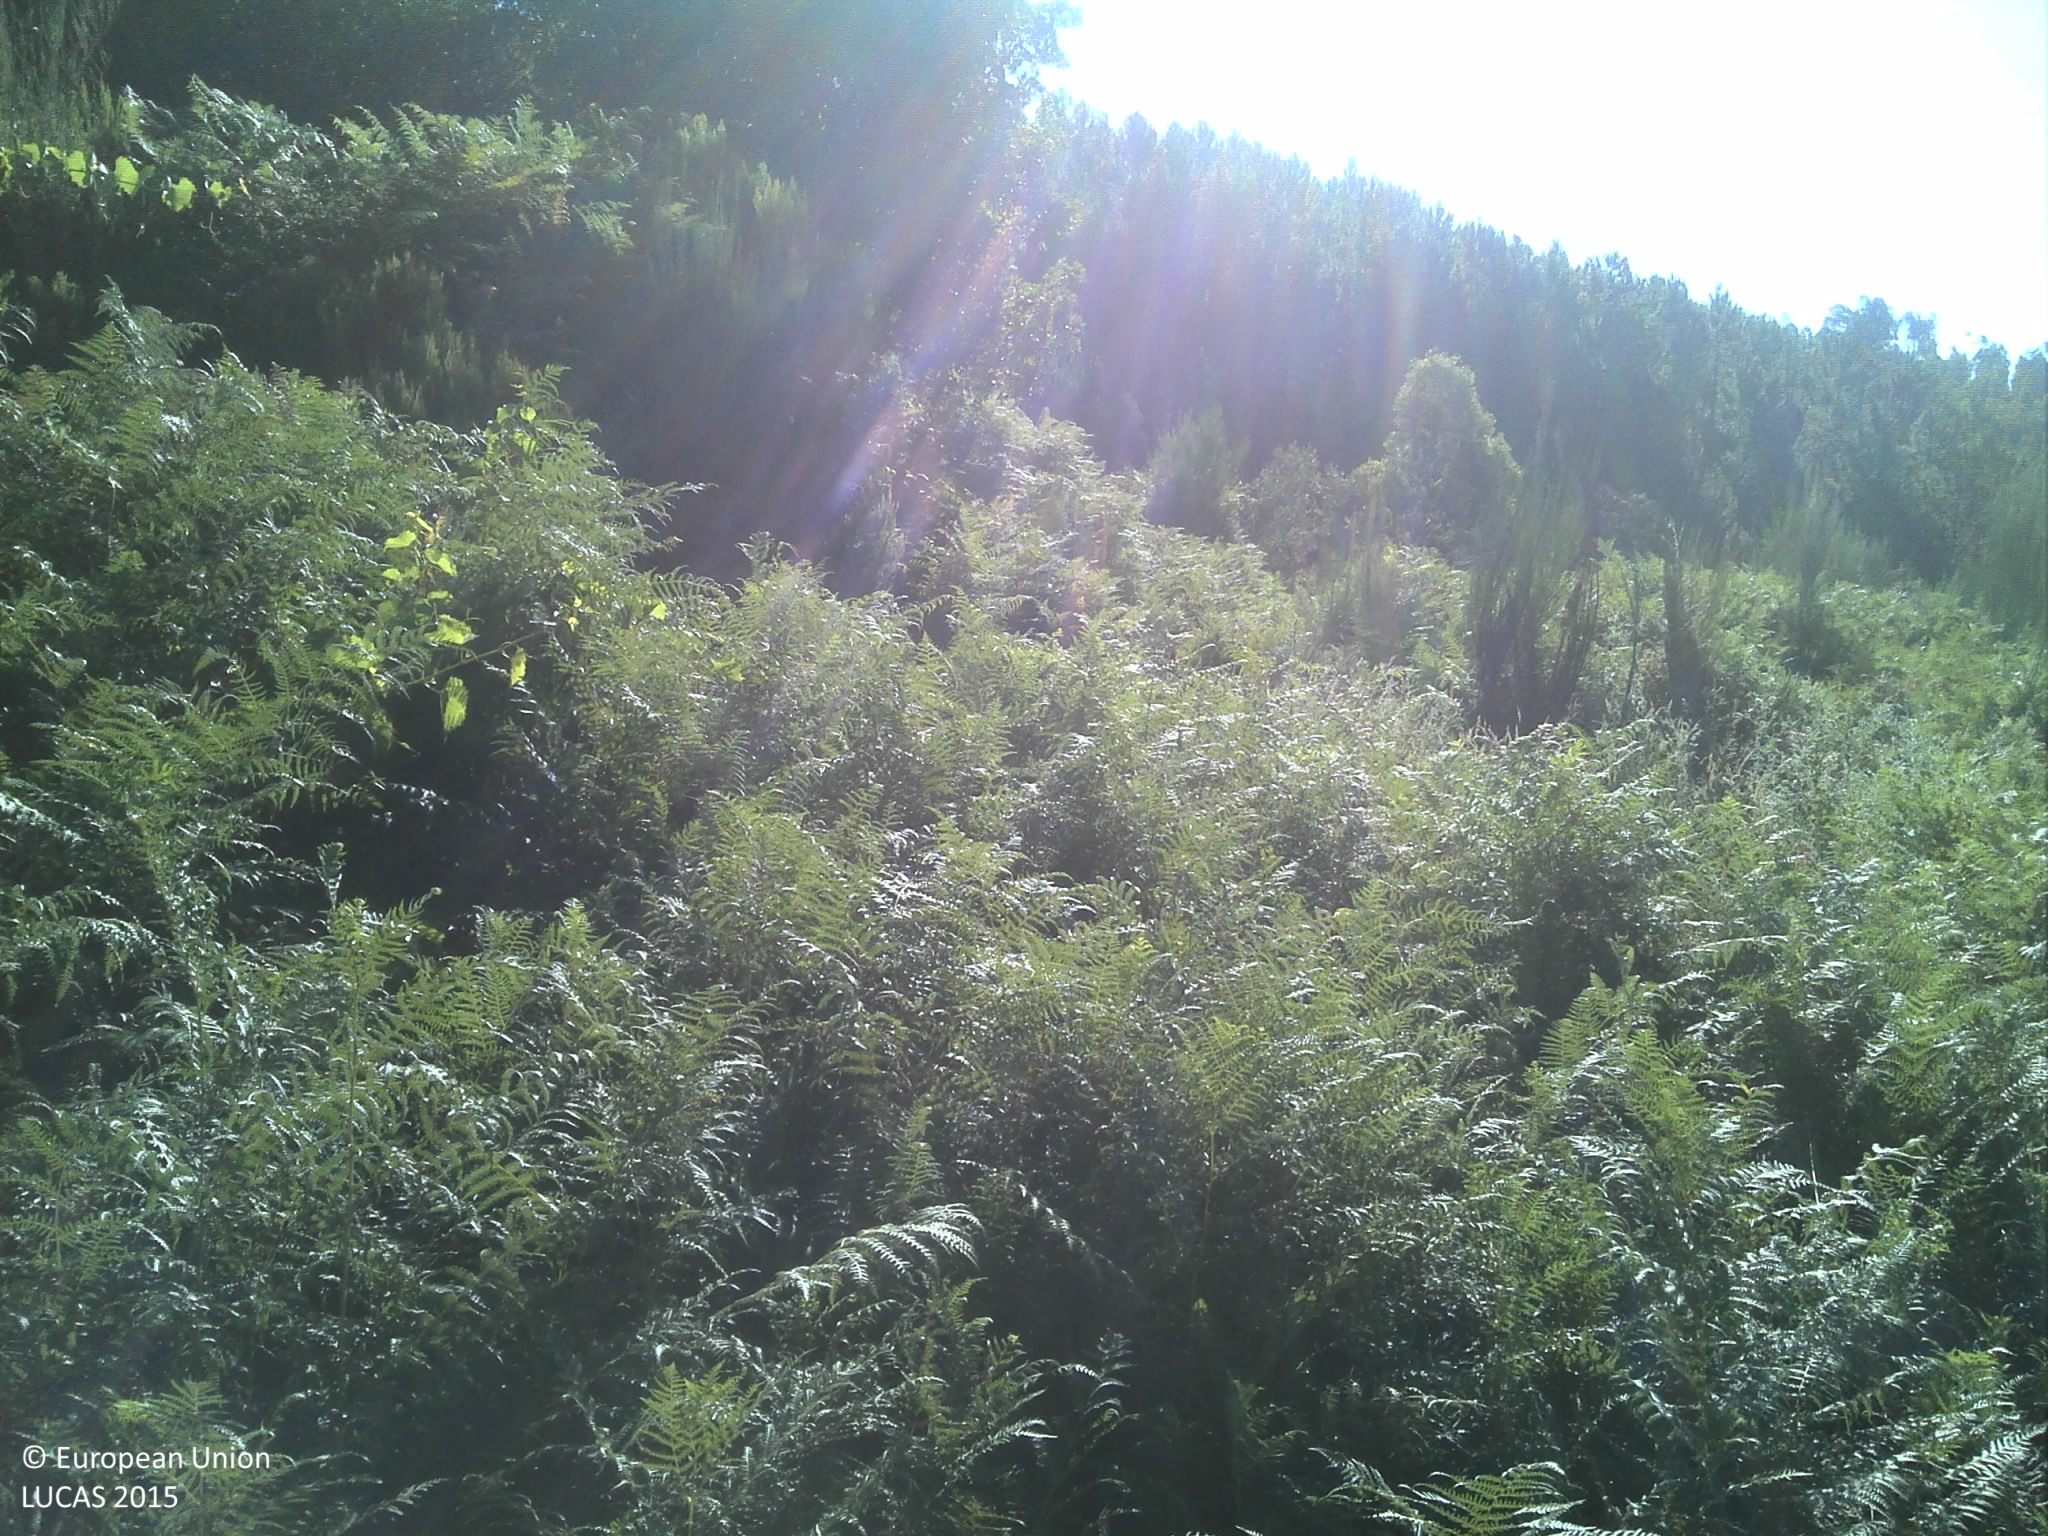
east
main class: Shrubland
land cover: Shrubland with sparse tree cover
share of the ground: 50 - 75 %
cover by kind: shrubs 70 %, unconsolidated bare surface 20 %, coniferous forest trees 5 %, consolidated bare surface 5 %
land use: Abandoned areas
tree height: > 5 m
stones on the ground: 10 - 25 %
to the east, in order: Shrubland with sparse tree cover; Rivers and streams; Shrubland with sparse tree cover; Pine dominated coniferous woodland; Shrubland with sparse tree cover
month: July
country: PT
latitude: 40.2389
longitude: -7.6597
